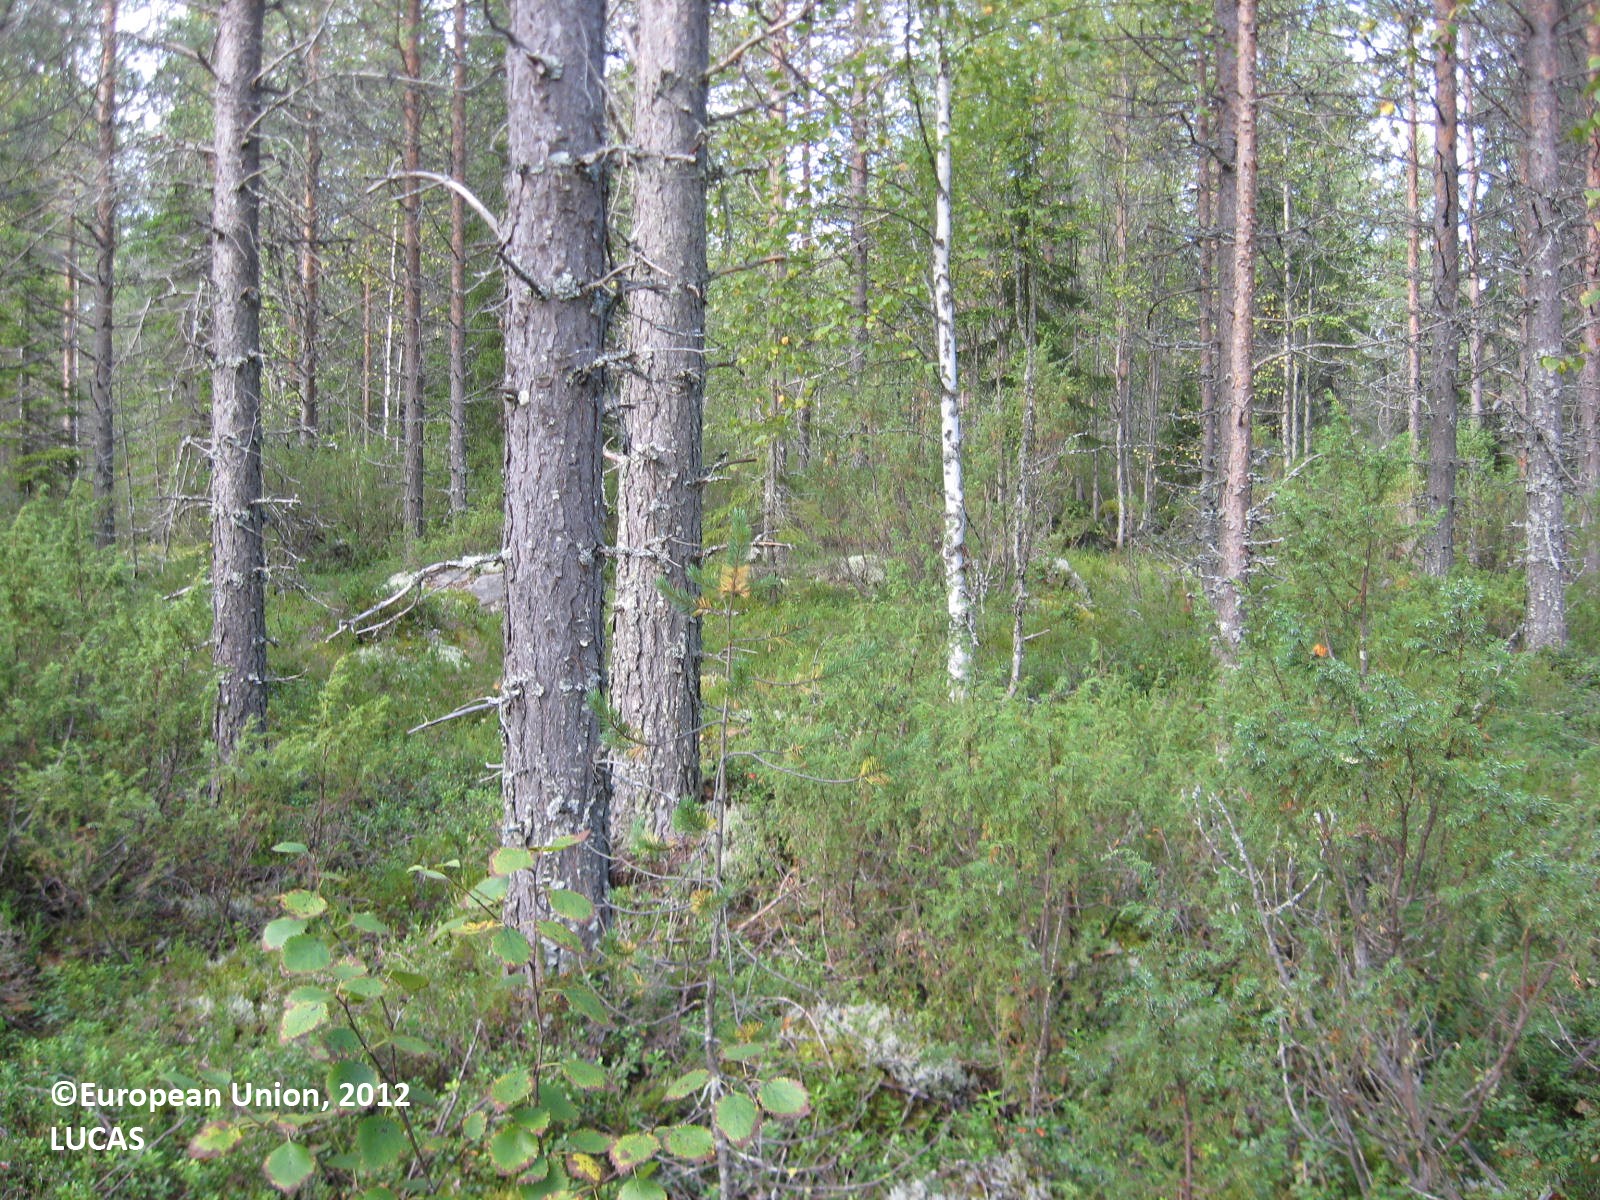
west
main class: Woodland
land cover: Pine dominated coniferous woodland
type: boreal forest
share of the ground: > 75 %
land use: Forestry
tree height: > 5 m
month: August
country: FI
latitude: 63.6925
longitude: 29.4980
